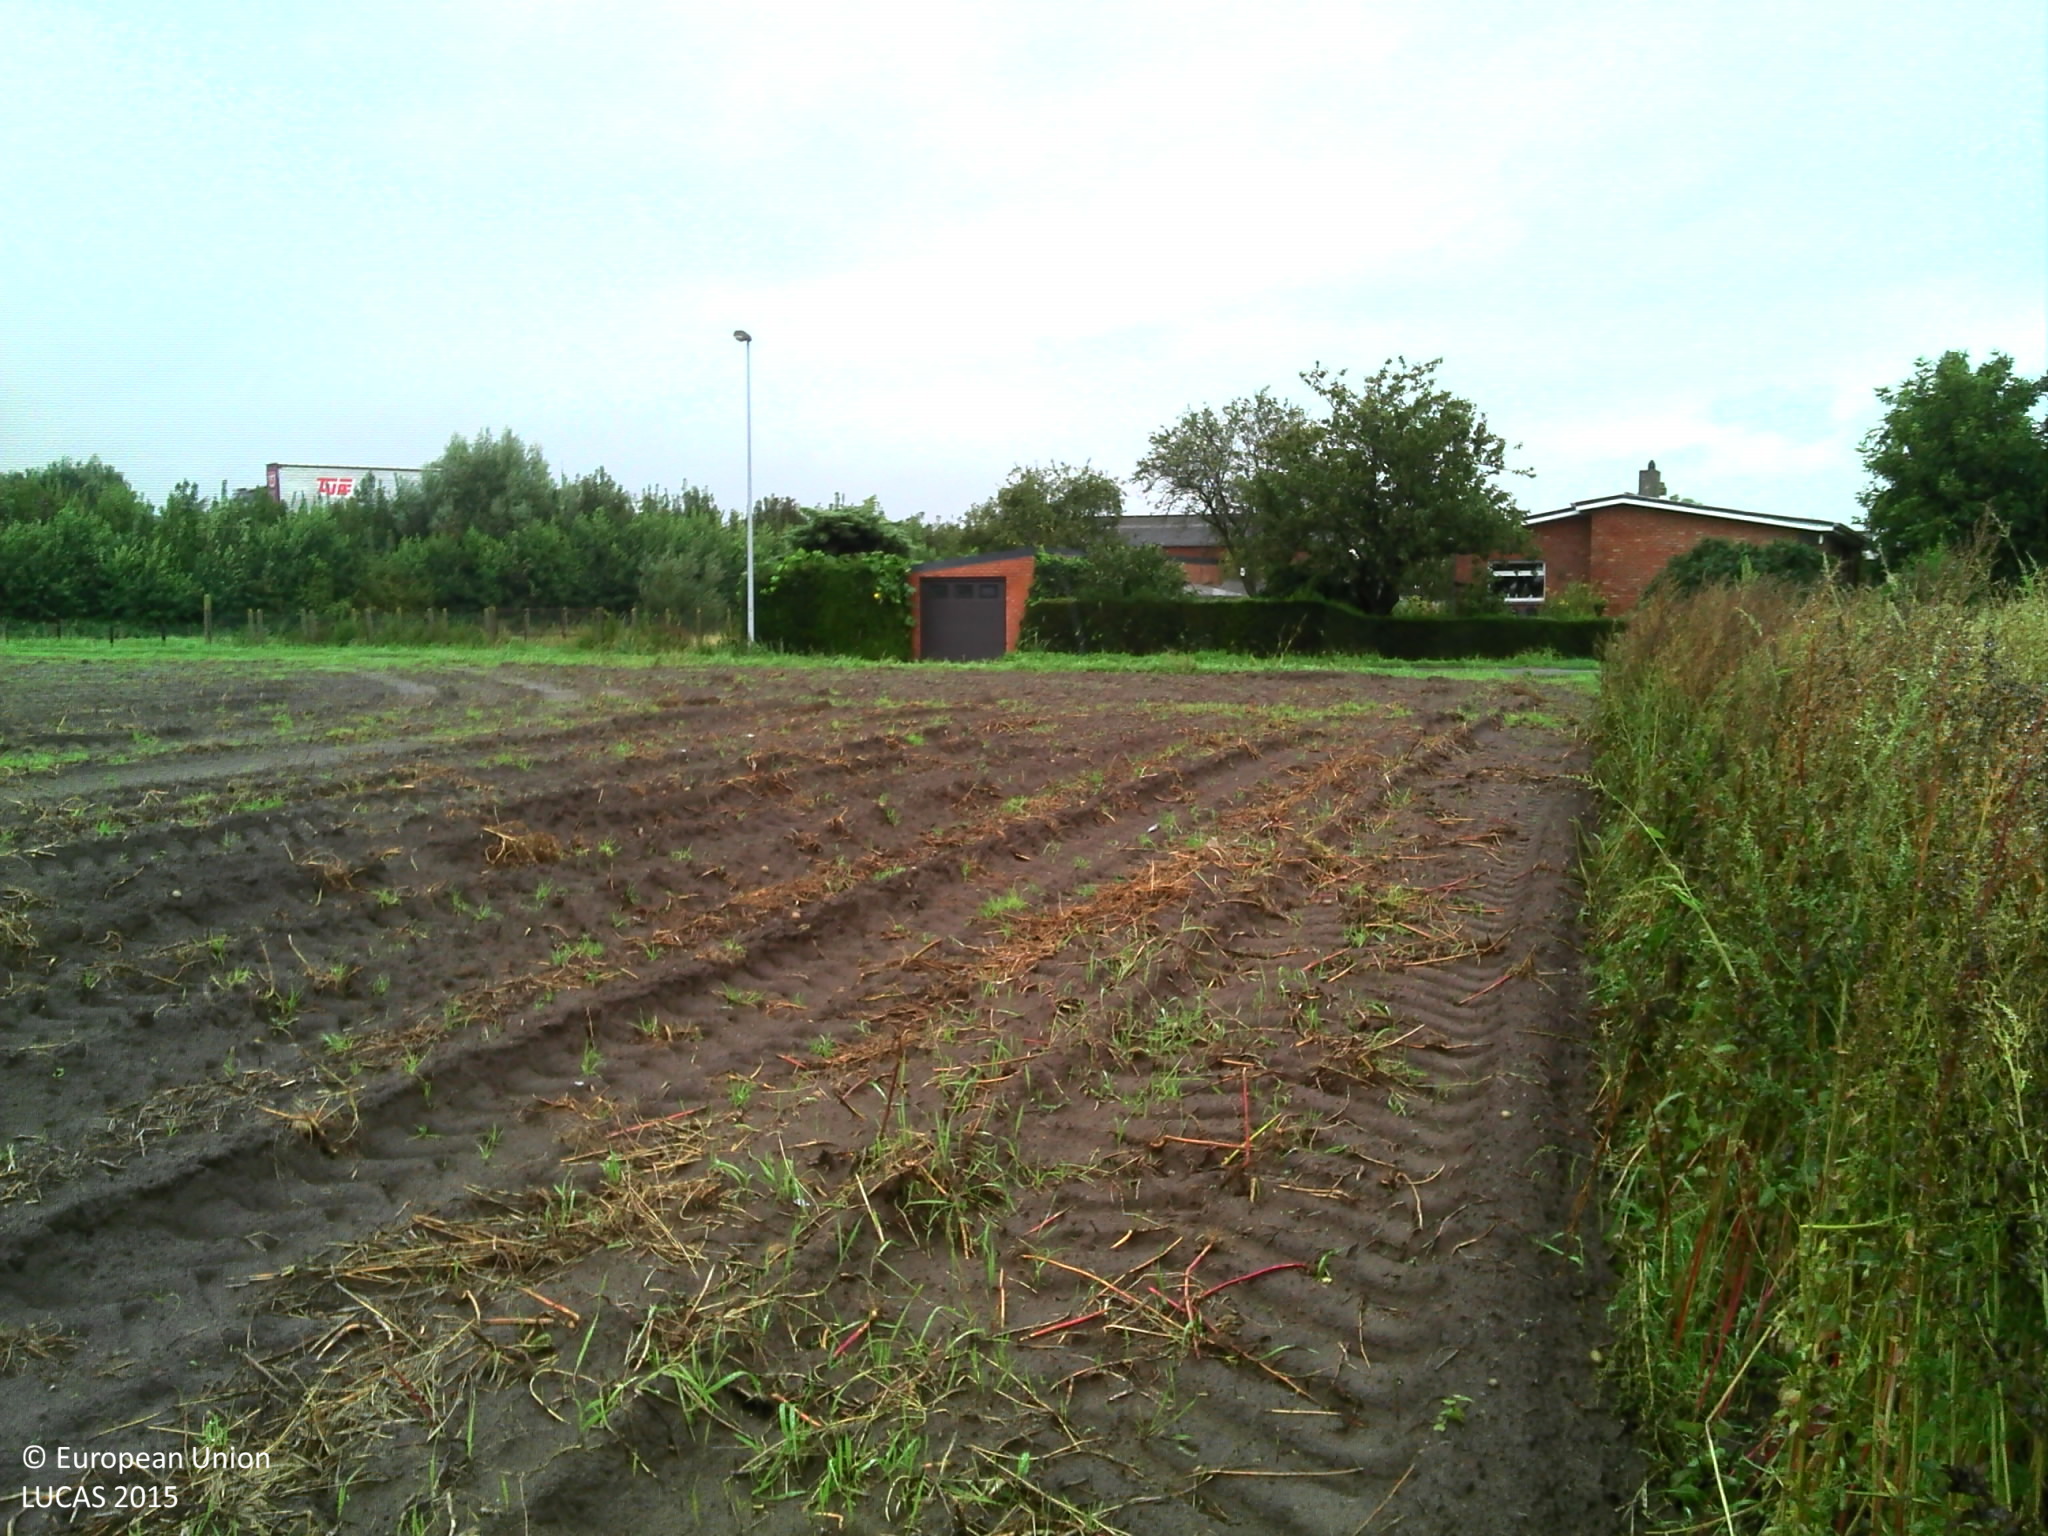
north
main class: Grassland
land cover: Spontaneously vegetated surfaces
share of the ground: > 75 %
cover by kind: herbaceous plants 100 %
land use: Fallow land
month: September
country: BE
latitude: 51.1797
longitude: 3.0234
